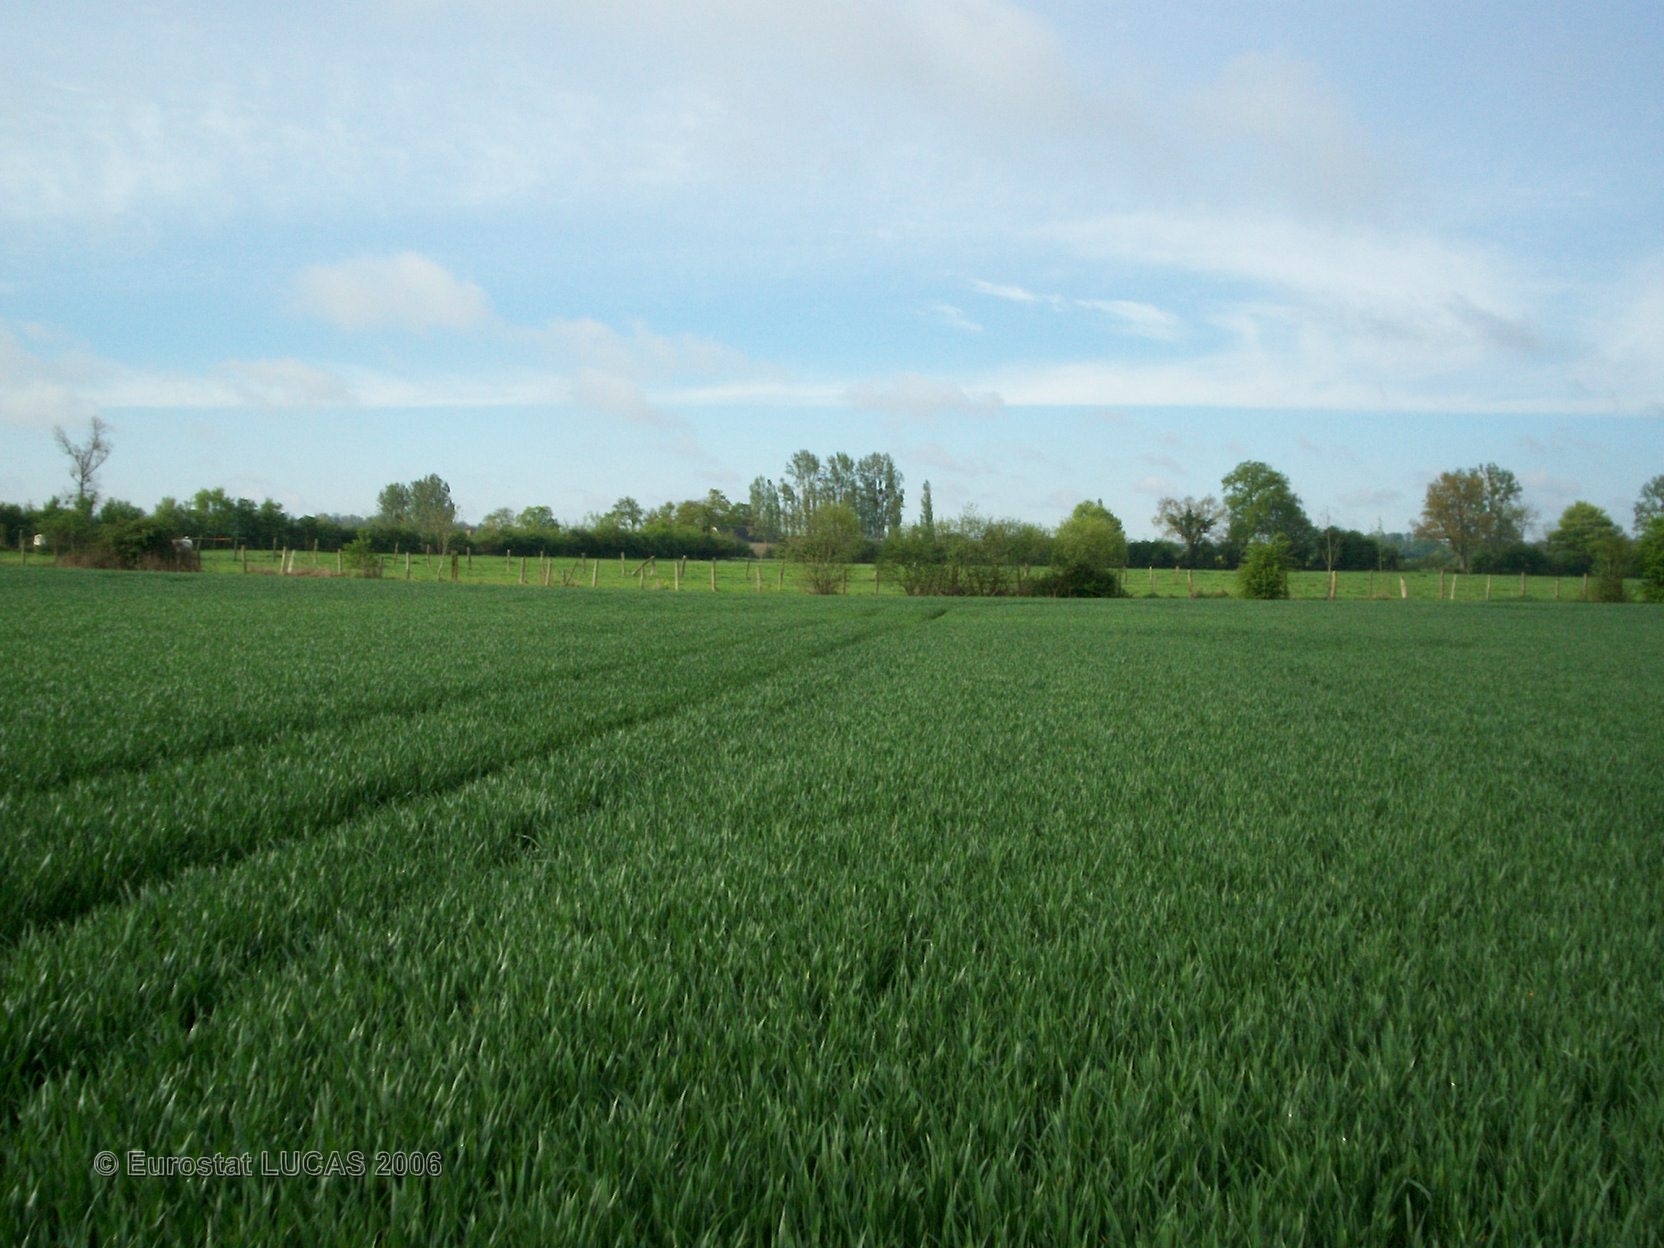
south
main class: Cropland
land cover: Common wheat
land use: Agriculture (excluding fallow land and kitchen gardens)
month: May
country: FR
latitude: 48.6260
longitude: 0.2721
